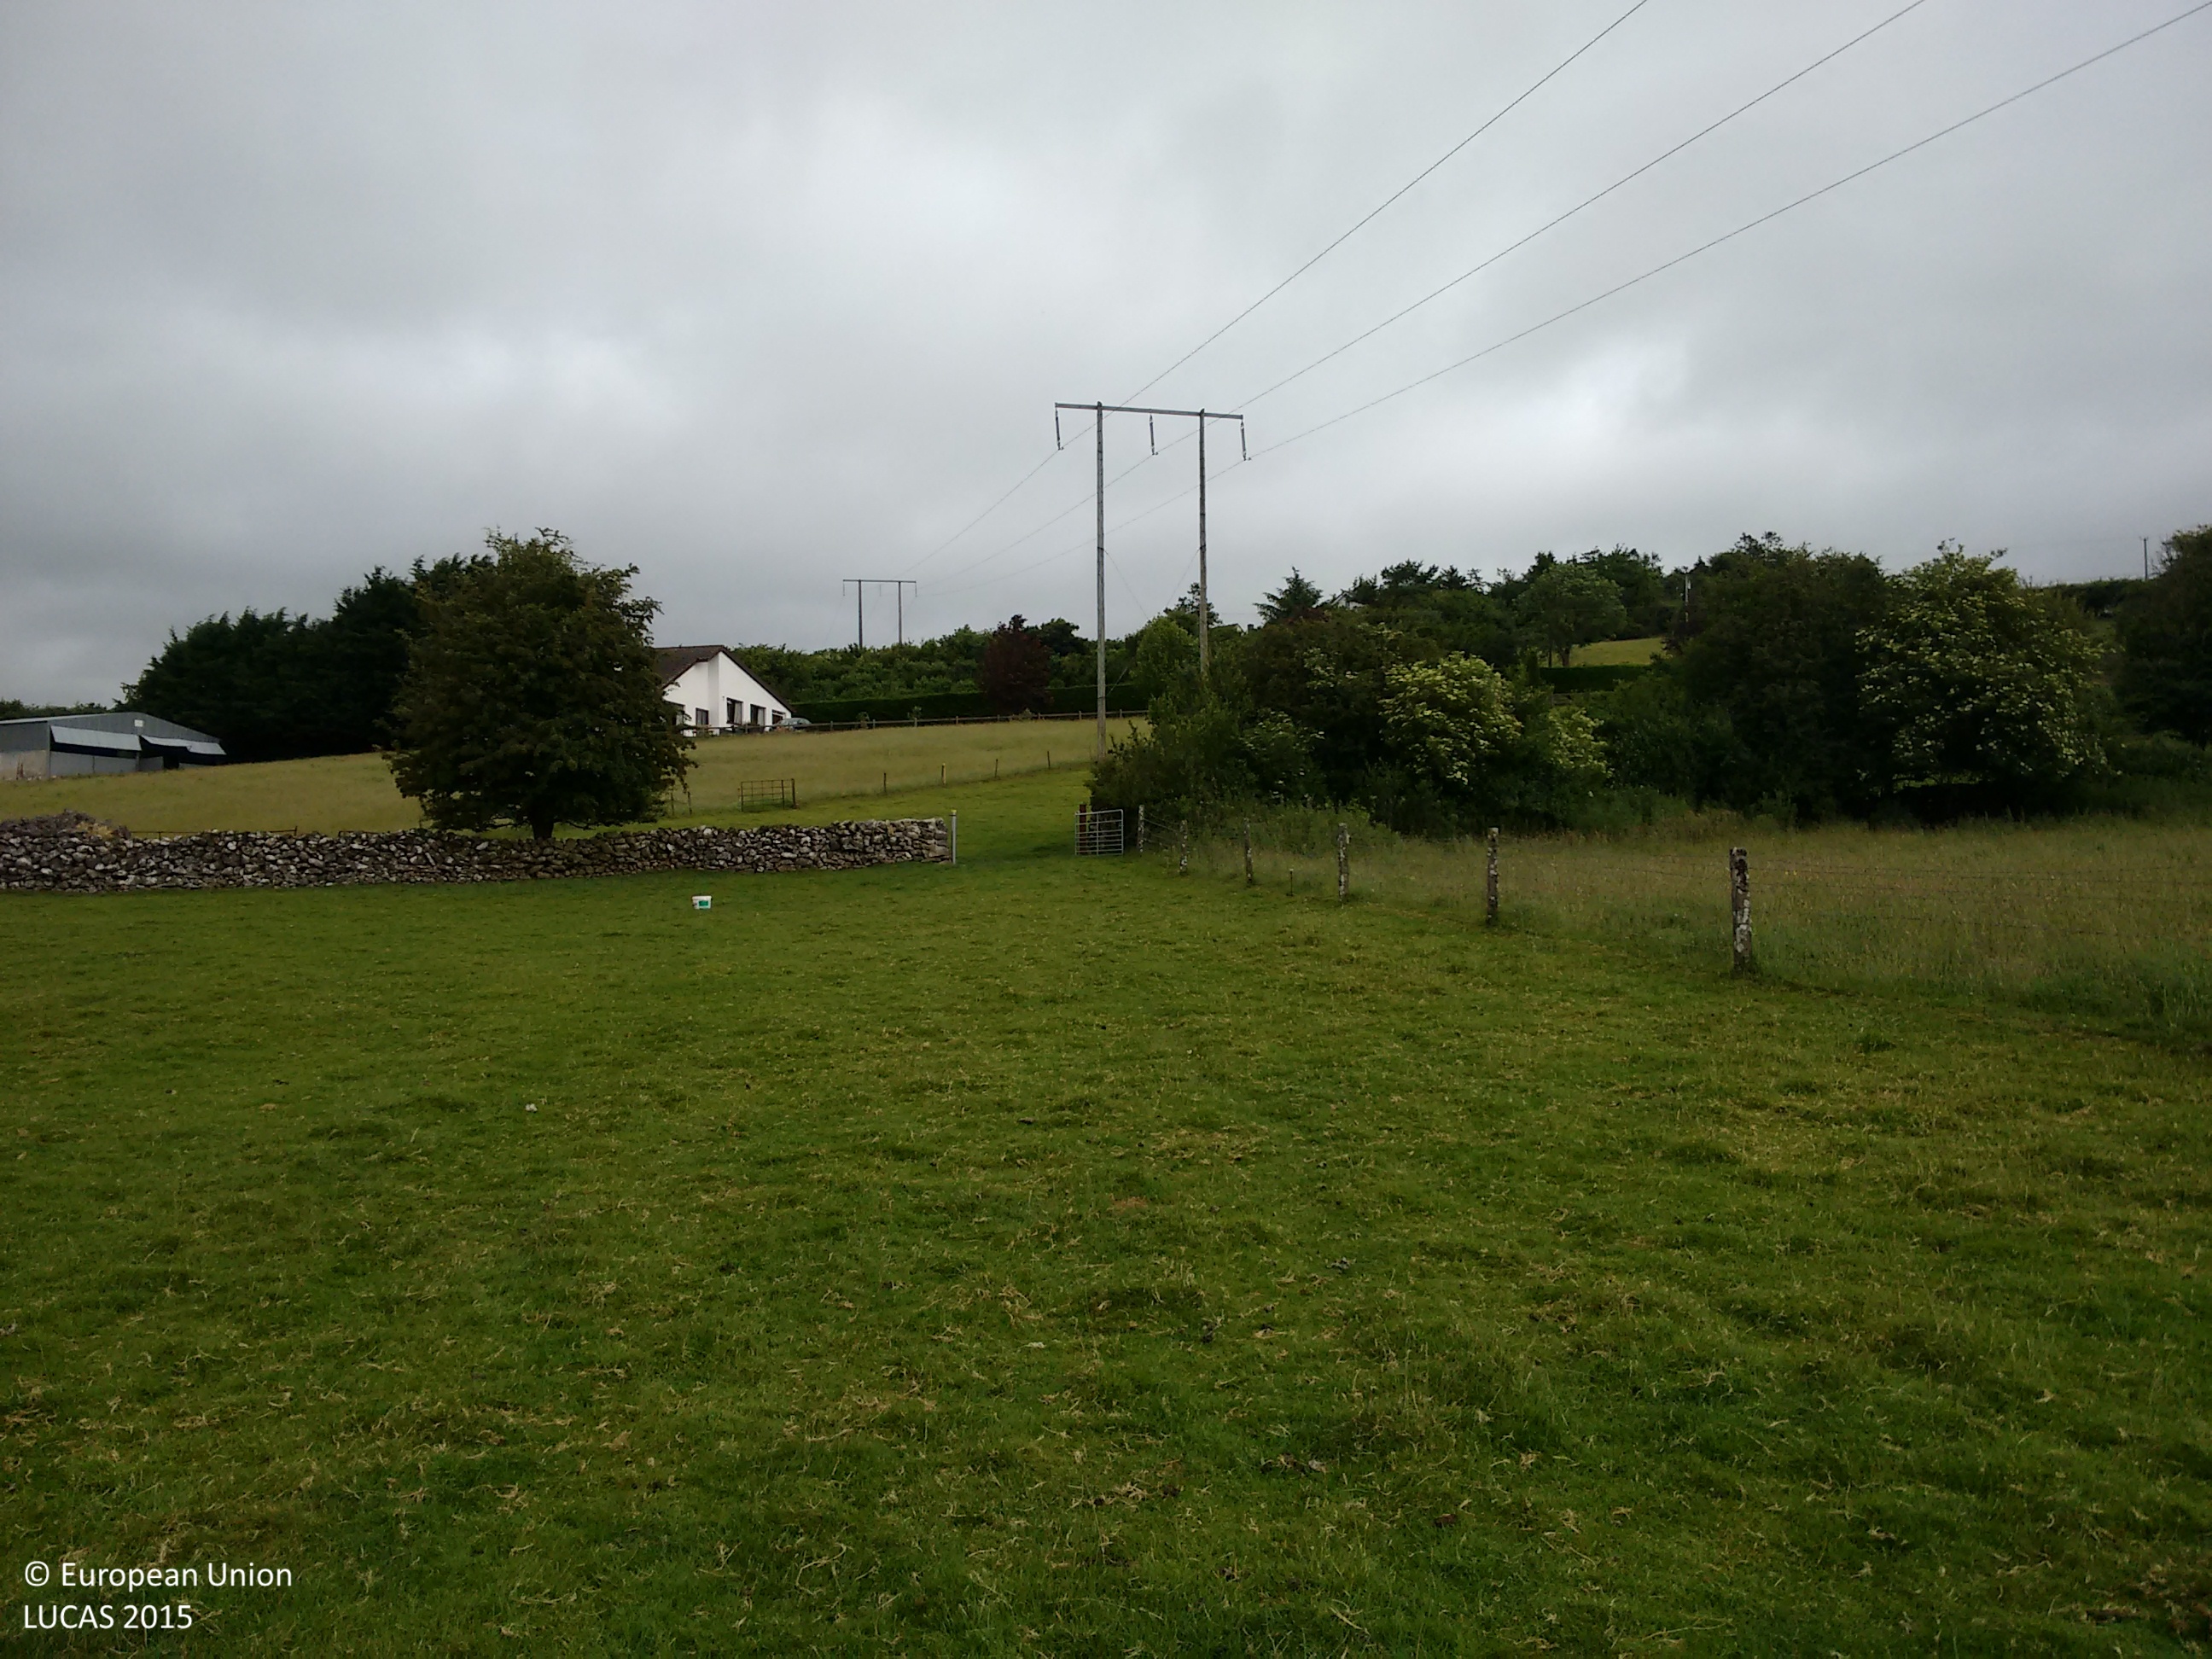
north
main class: Grassland
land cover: Grassland without tree/shrub cover
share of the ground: > 75 %
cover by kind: herbaceous plants 100 %
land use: Agriculture (excluding fallow land and kitchen gardens)
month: June
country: IE
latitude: 53.4715
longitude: -8.0286
